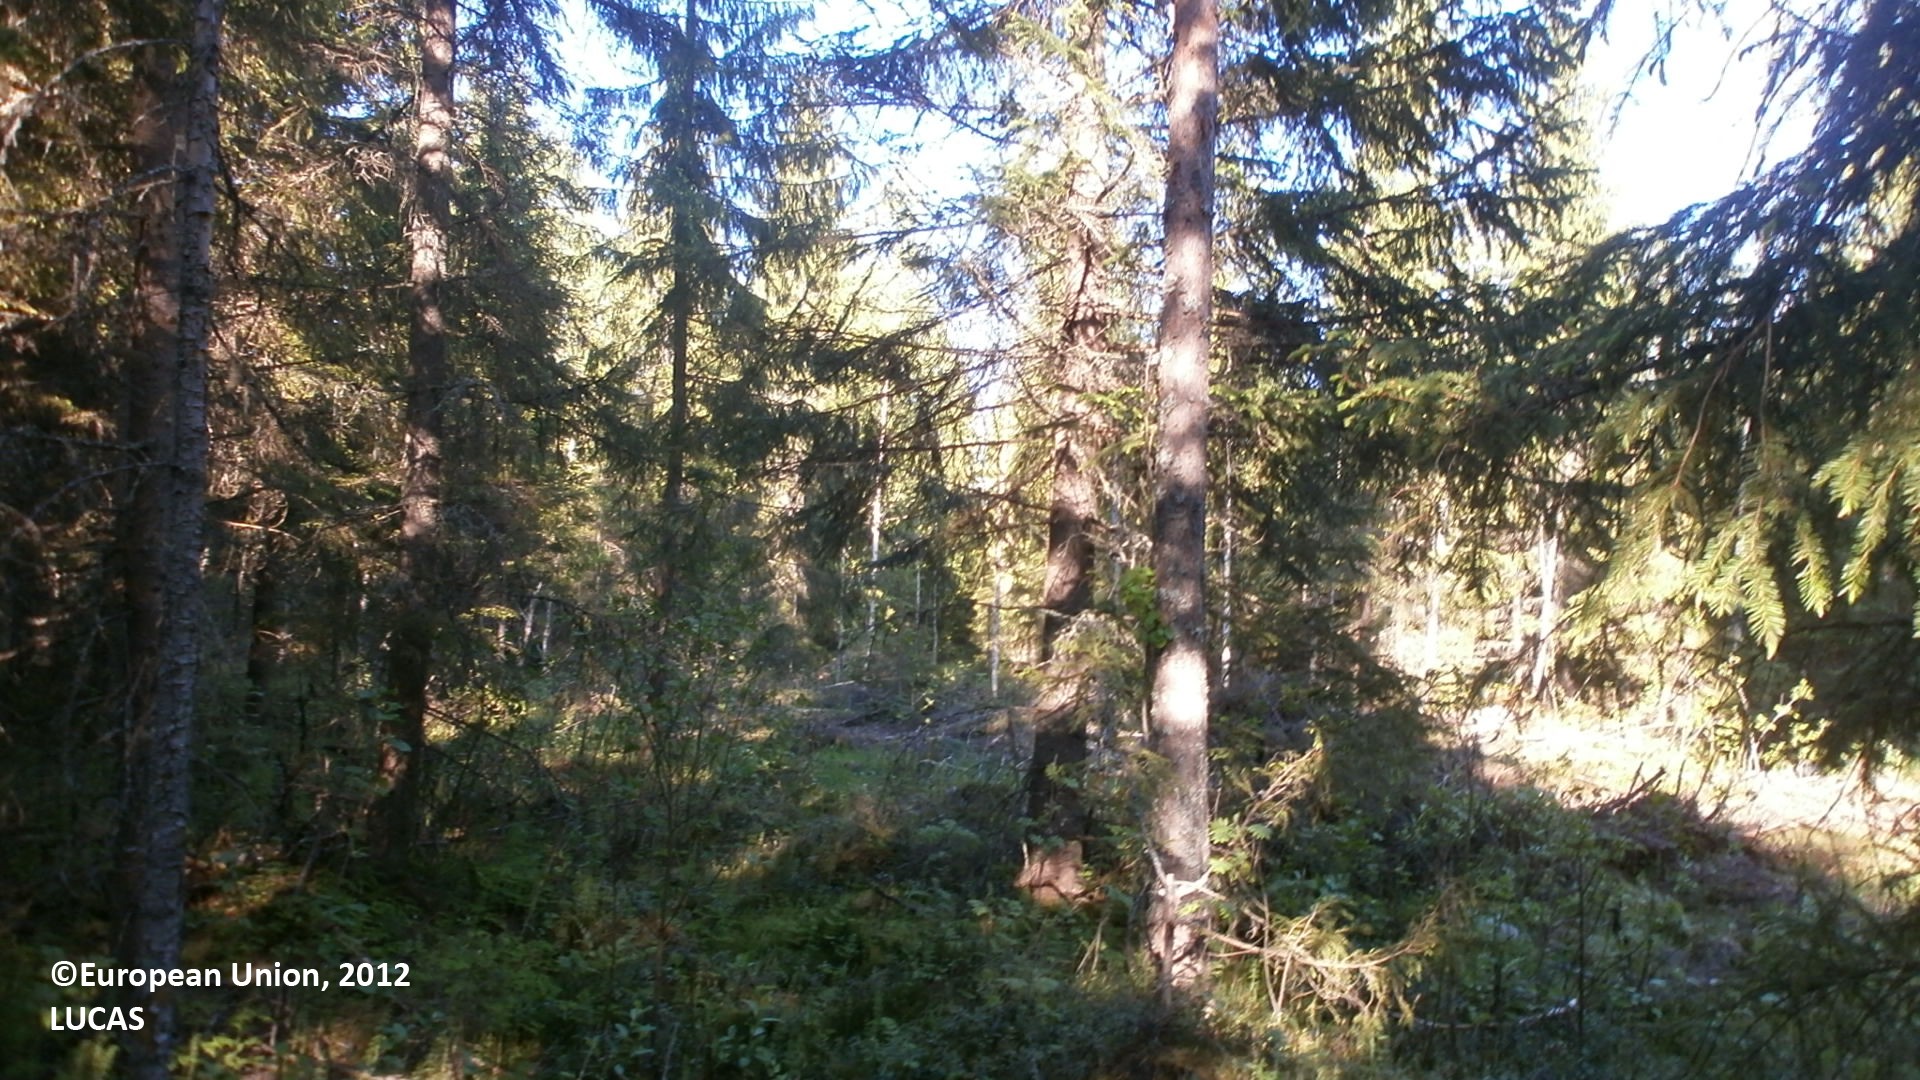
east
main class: Woodland
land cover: Spruce dominated coniferous woodland
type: mire and swamp forests
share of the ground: 50 - 75 %
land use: Forestry
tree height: > 5 m
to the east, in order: Spruce dominated coniferous woodland; Tracks; Spruce dominated coniferous woodland; Ditches and canals; Spruce dominated coniferous woodland; Ditches and canals; Other mixed woodland; Spruce dominated mixed woodland; Spruce dominated coniferous woodland
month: June
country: FI
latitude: 64.0853
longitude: 25.7485
